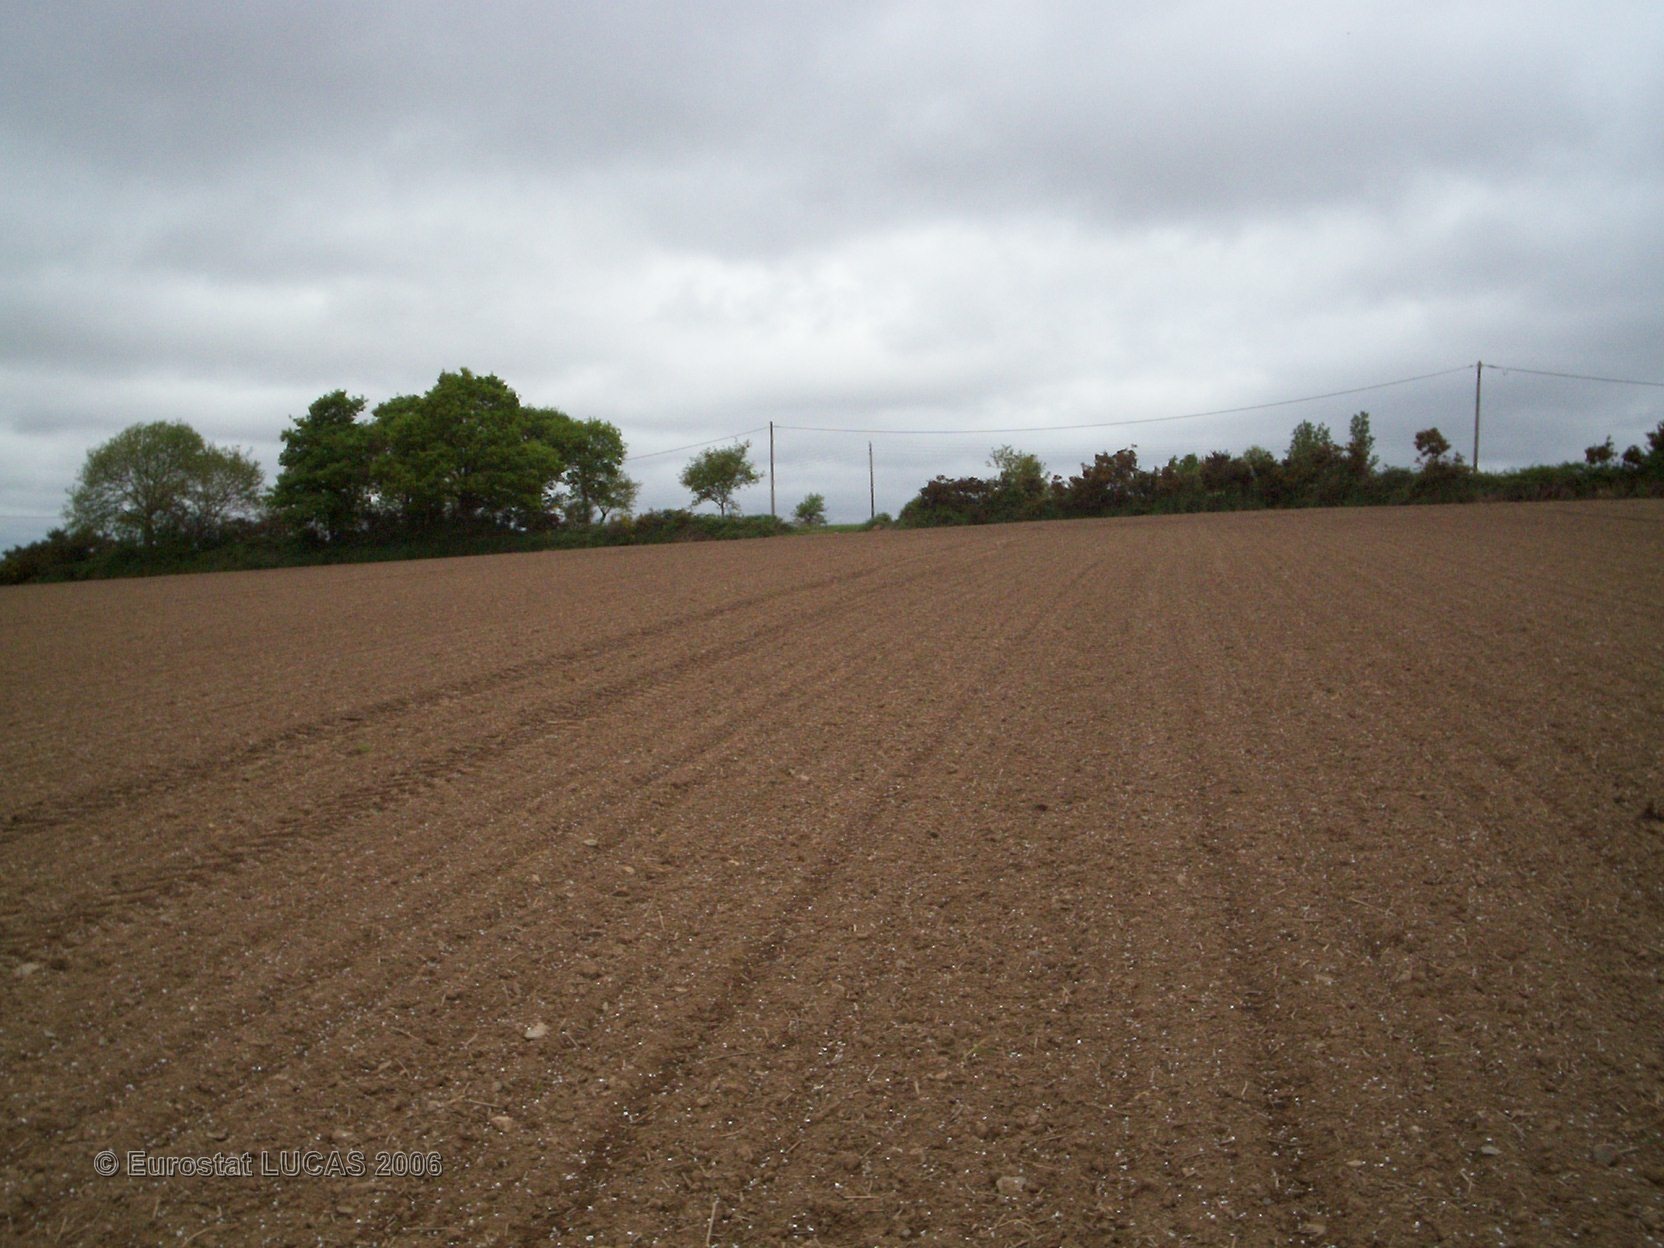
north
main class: Cropland
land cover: Maize
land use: Agriculture (excluding fallow land and kitchen gardens)
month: June
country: FR
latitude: 48.2192
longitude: -2.8118
